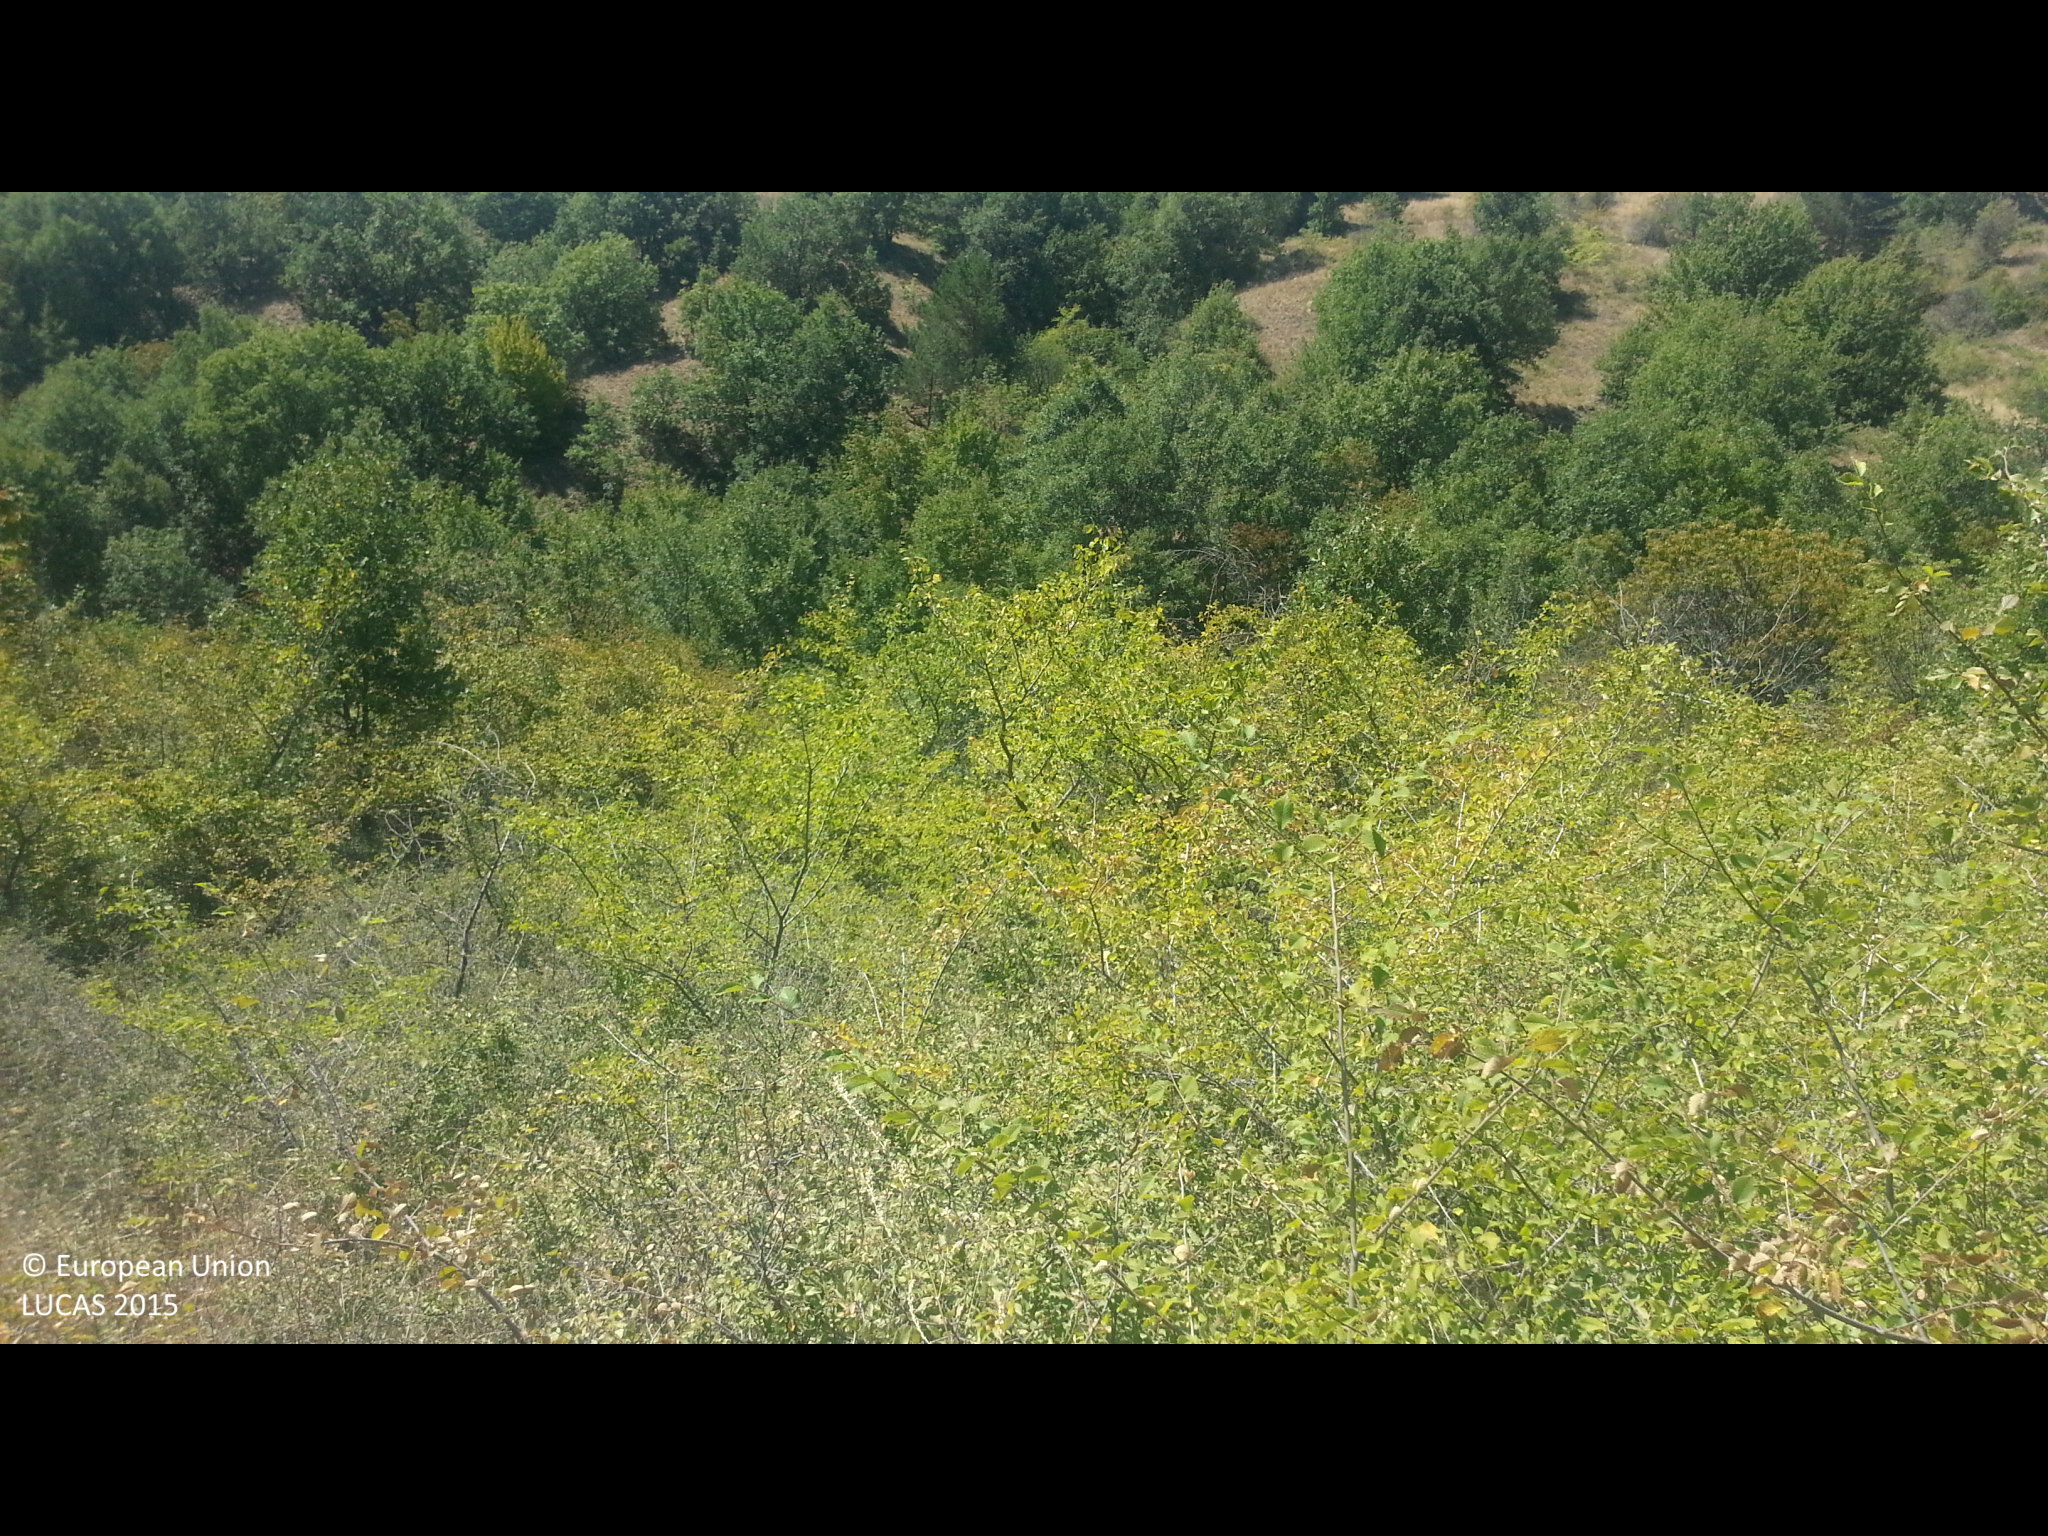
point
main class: Shrubland
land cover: Shrubland without tree cover
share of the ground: 50 - 75 %
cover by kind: shrubs 70 %, herbaceous plants 30 %
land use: Semi-natural and natural areas not in use
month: September
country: BG
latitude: 42.1935
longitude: 23.0186
